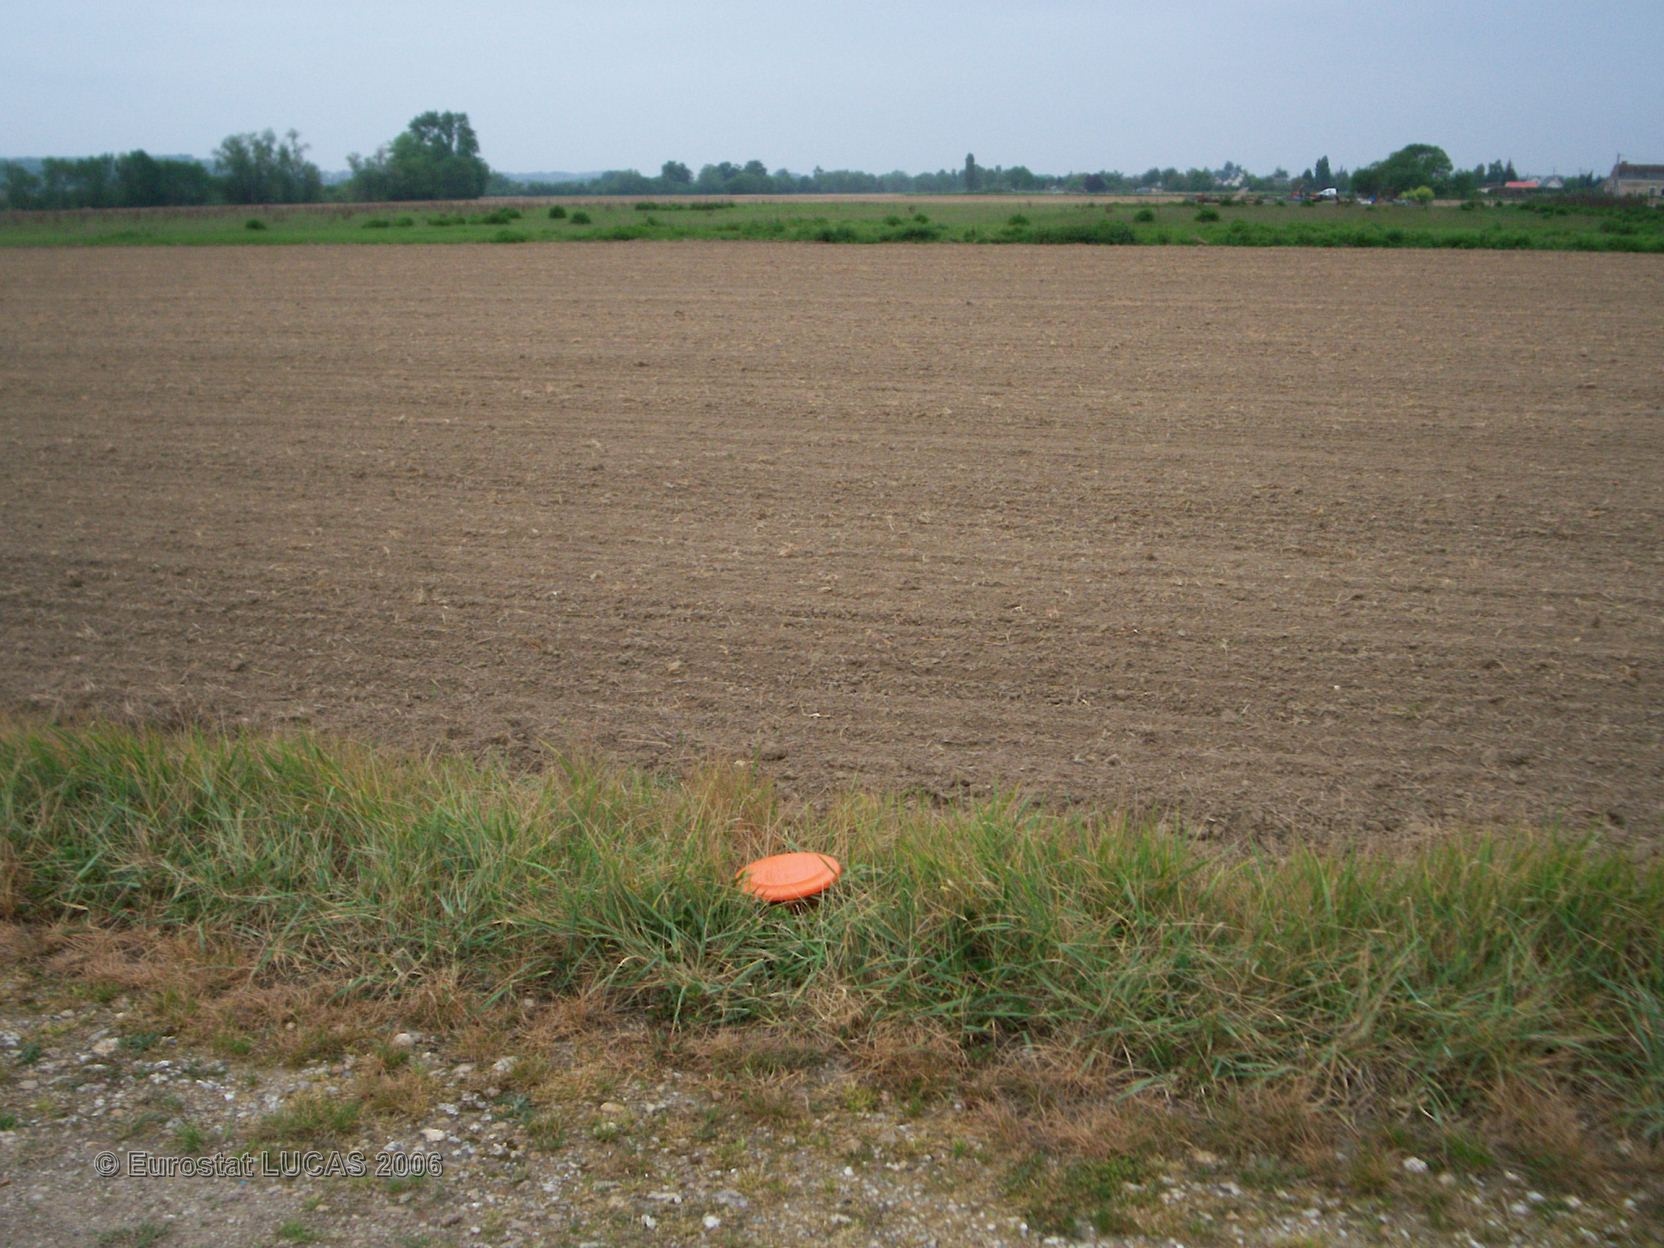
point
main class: Cropland
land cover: Common wheat
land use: Agriculture (excluding fallow land and kitchen gardens)
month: May
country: FR
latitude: 47.3629
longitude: 0.5387
